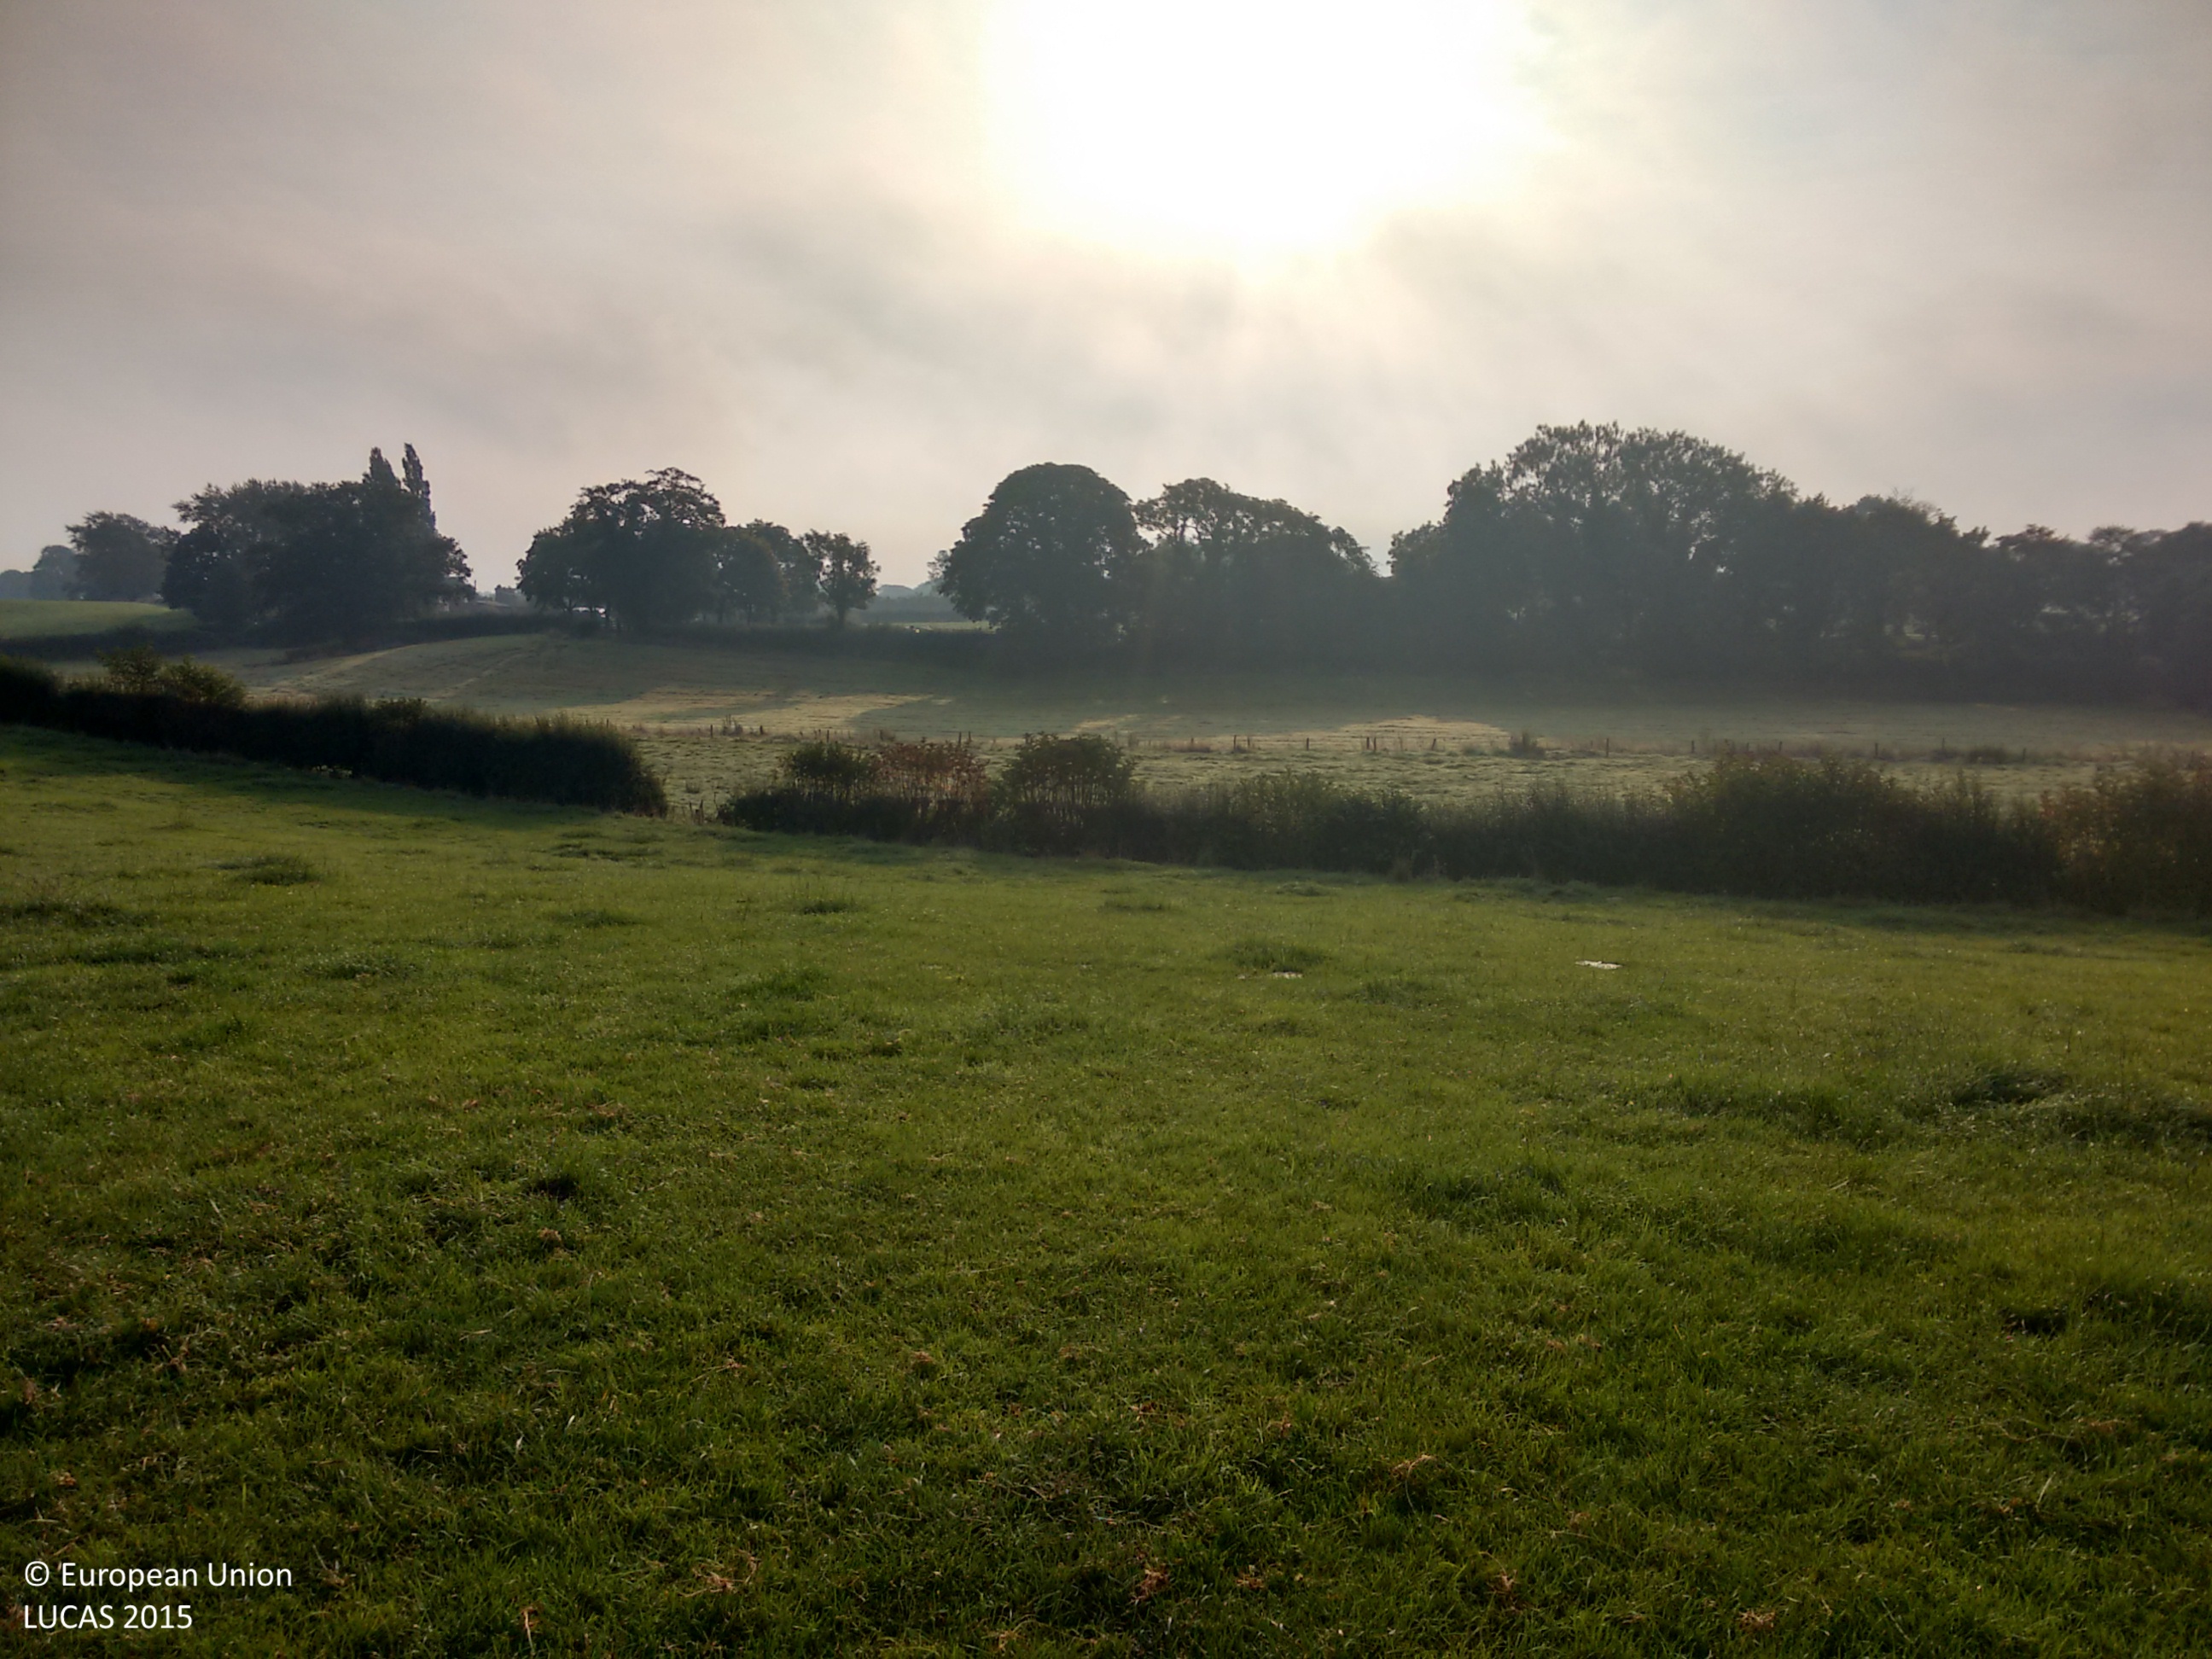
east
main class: Grassland
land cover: Grassland without tree/shrub cover
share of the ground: > 75 %
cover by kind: herbaceous plants 100 %
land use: Agriculture (excluding fallow land and kitchen gardens)
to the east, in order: Grassland without tree/shrub cover; Ditches and canals; Grassland without tree/shrub cover; Fences; Grass margins; Ditches and canals; Fences; Grassland without tree/shrub cover; Managed hedges; Single bushes/trees; Grassland without tree/shrub cover; Paved roads, cycling and walking lanes; Grass margins; Lines of trees; Grass margins; Paved roads, cycling and walking lanes; Grass margins; Fences; Grassland without tree/shrub cover
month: September
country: GB
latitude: 52.9384
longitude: -2.7929
